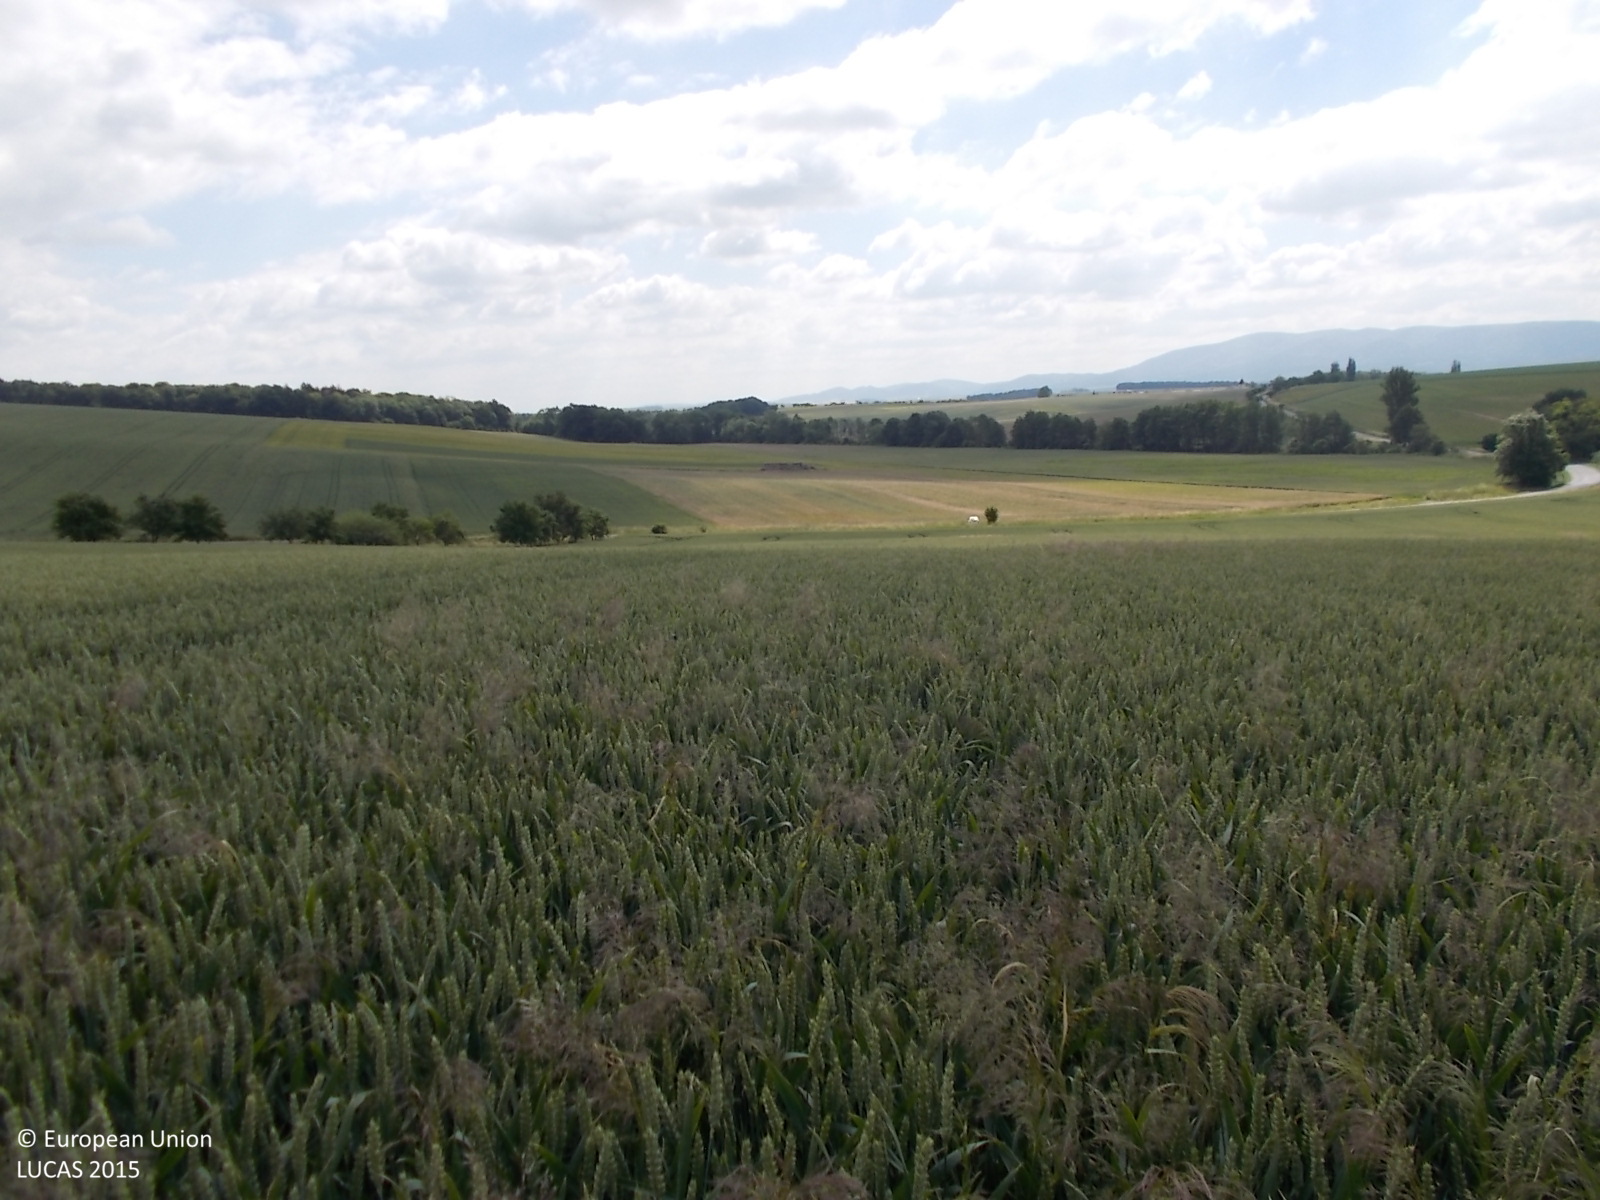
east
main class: Cropland
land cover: Common wheat
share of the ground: > 75 %
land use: Agriculture (excluding fallow land and kitchen gardens)
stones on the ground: < 10 %
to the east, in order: Common wheat; Lines of trees; Grass margins; Tracks; Spontaneously vegetated surfaces; Ditches and canals; Grass margins; Paved roads, cycling and walking lanes; Grass margins; Ditches and canals; Grass margins; Common wheat
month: June
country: CZ
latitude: 49.4597
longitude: 17.6146
